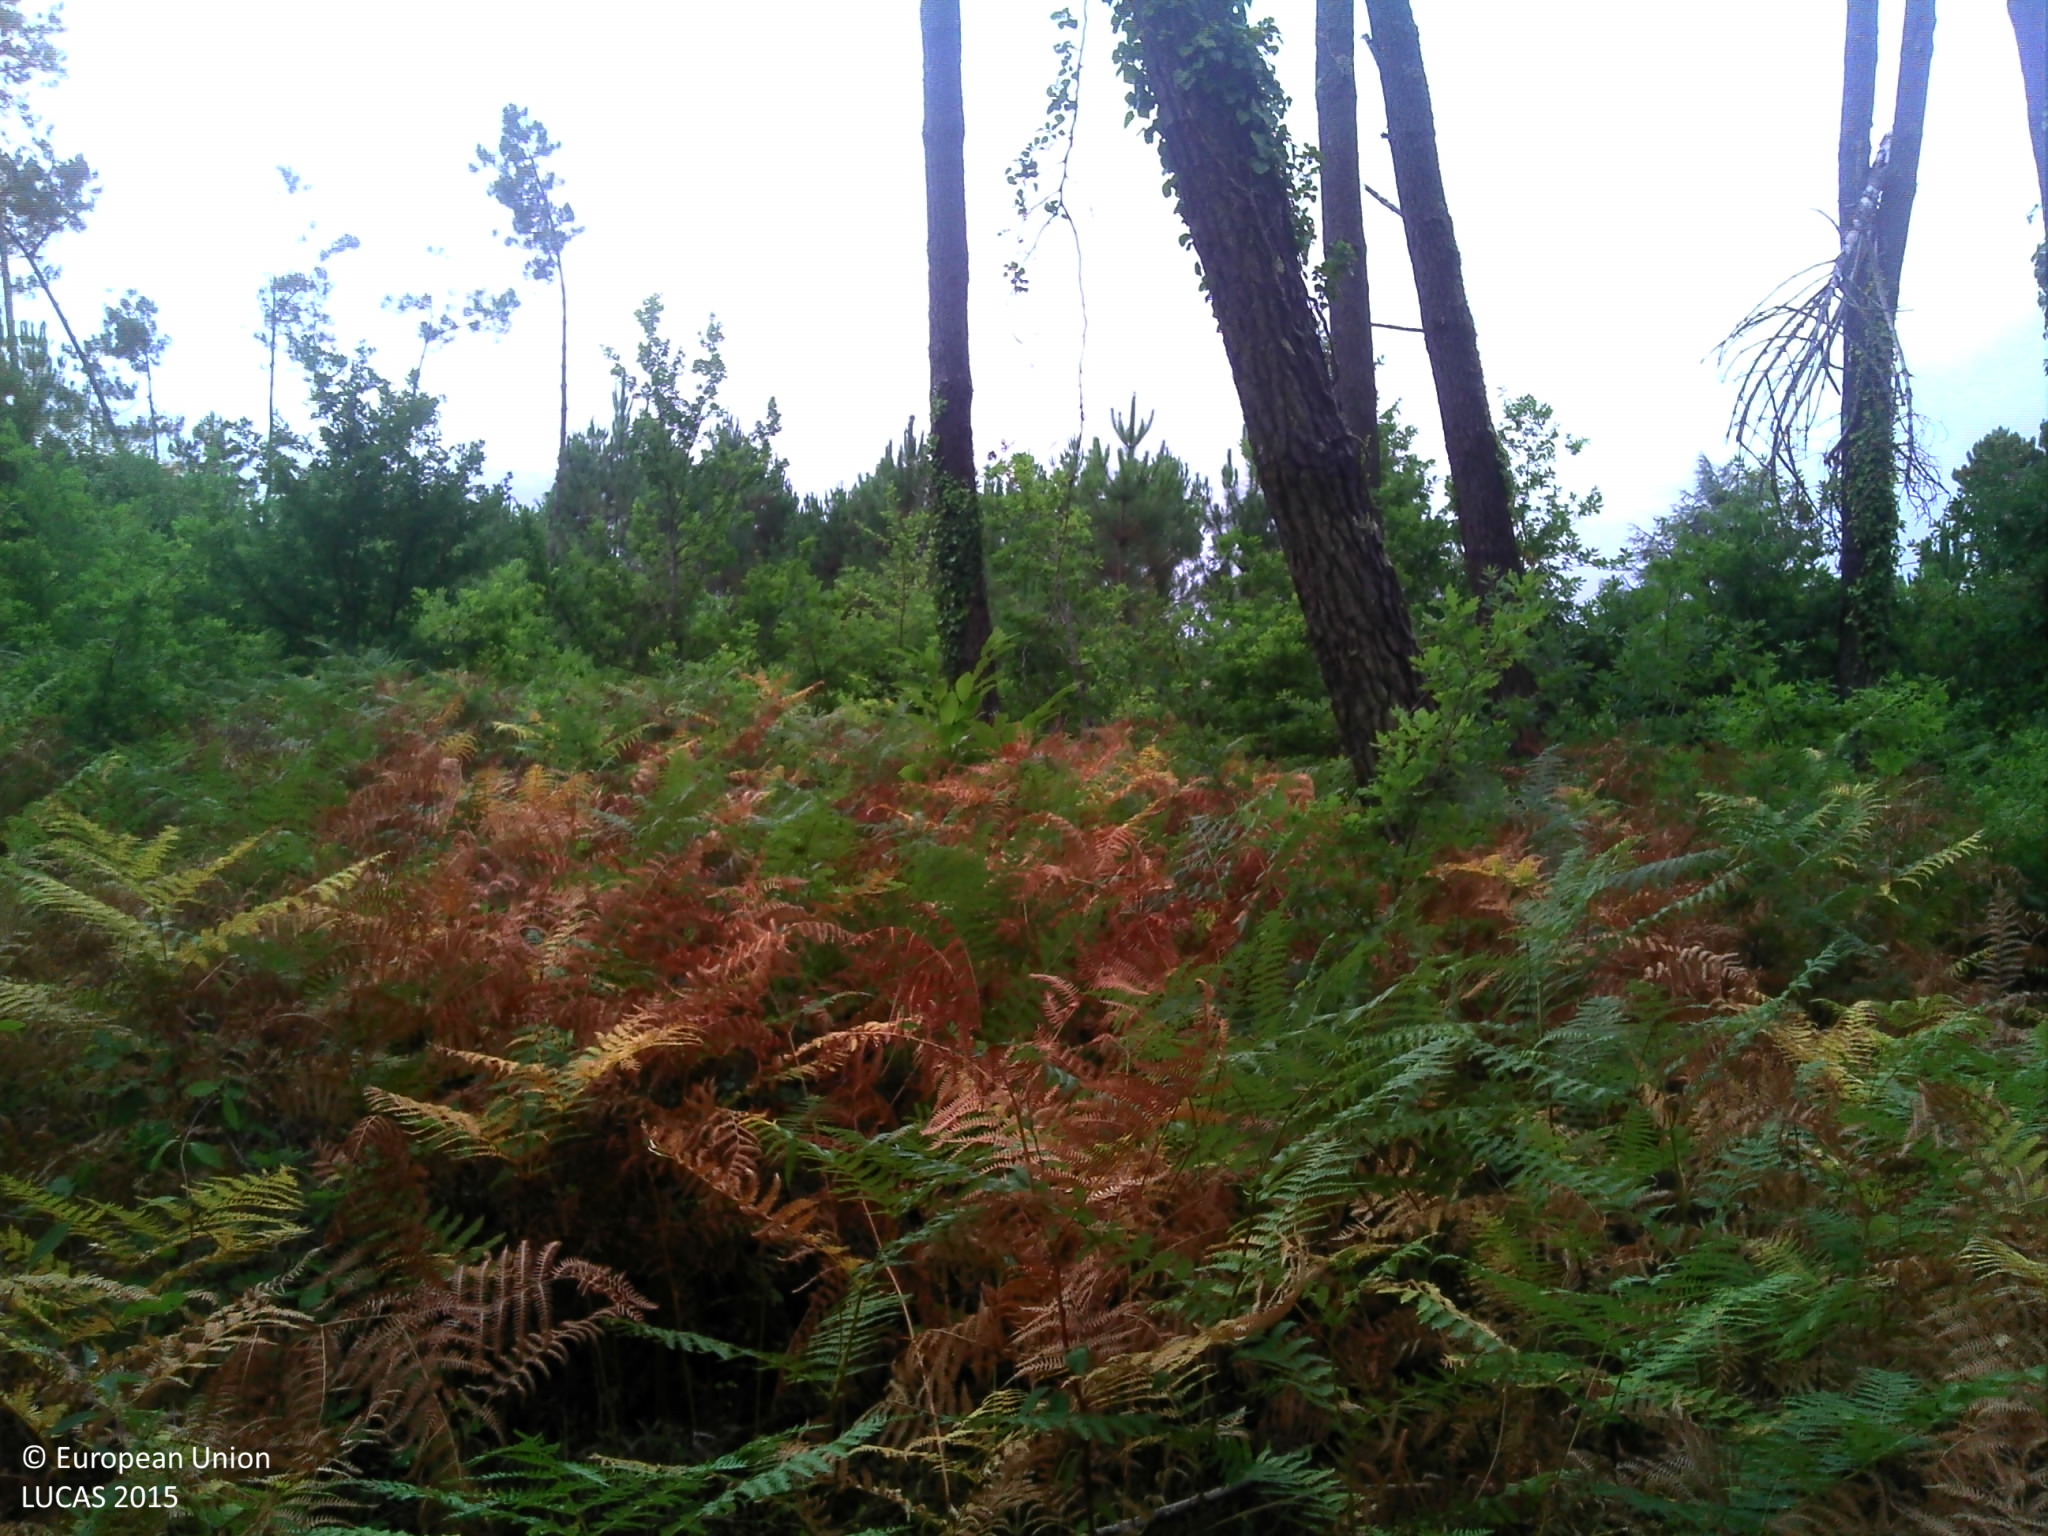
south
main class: Woodland
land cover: Pine dominated coniferous woodland
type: exotic forest
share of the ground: > 75 %
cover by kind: coniferous forest trees 80 %, herbaceous plants 20 %
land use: Forestry
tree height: > 5 m
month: July
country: FR
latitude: 44.3536
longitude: -1.0984
